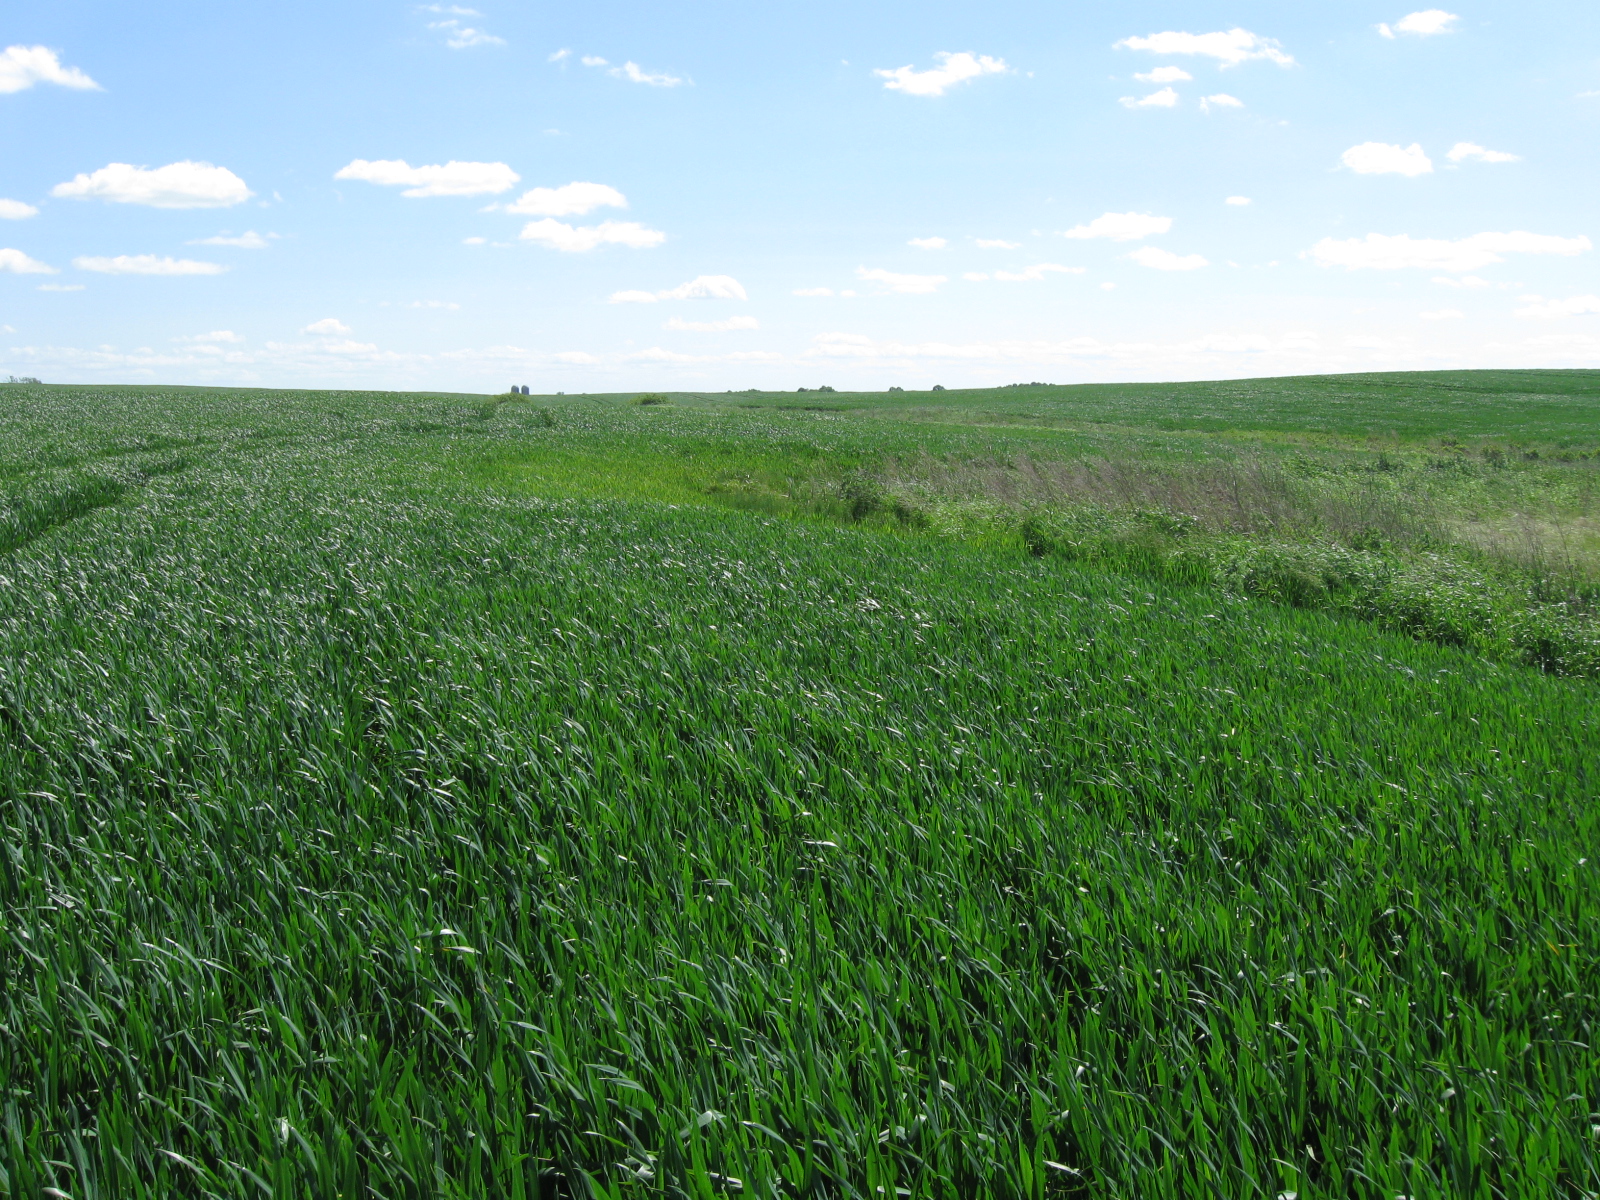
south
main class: Cropland
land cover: Common wheat
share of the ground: > 75 %
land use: Agriculture (excluding fallow land and kitchen gardens)
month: June
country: LT
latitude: 54.4123
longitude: 23.8174
